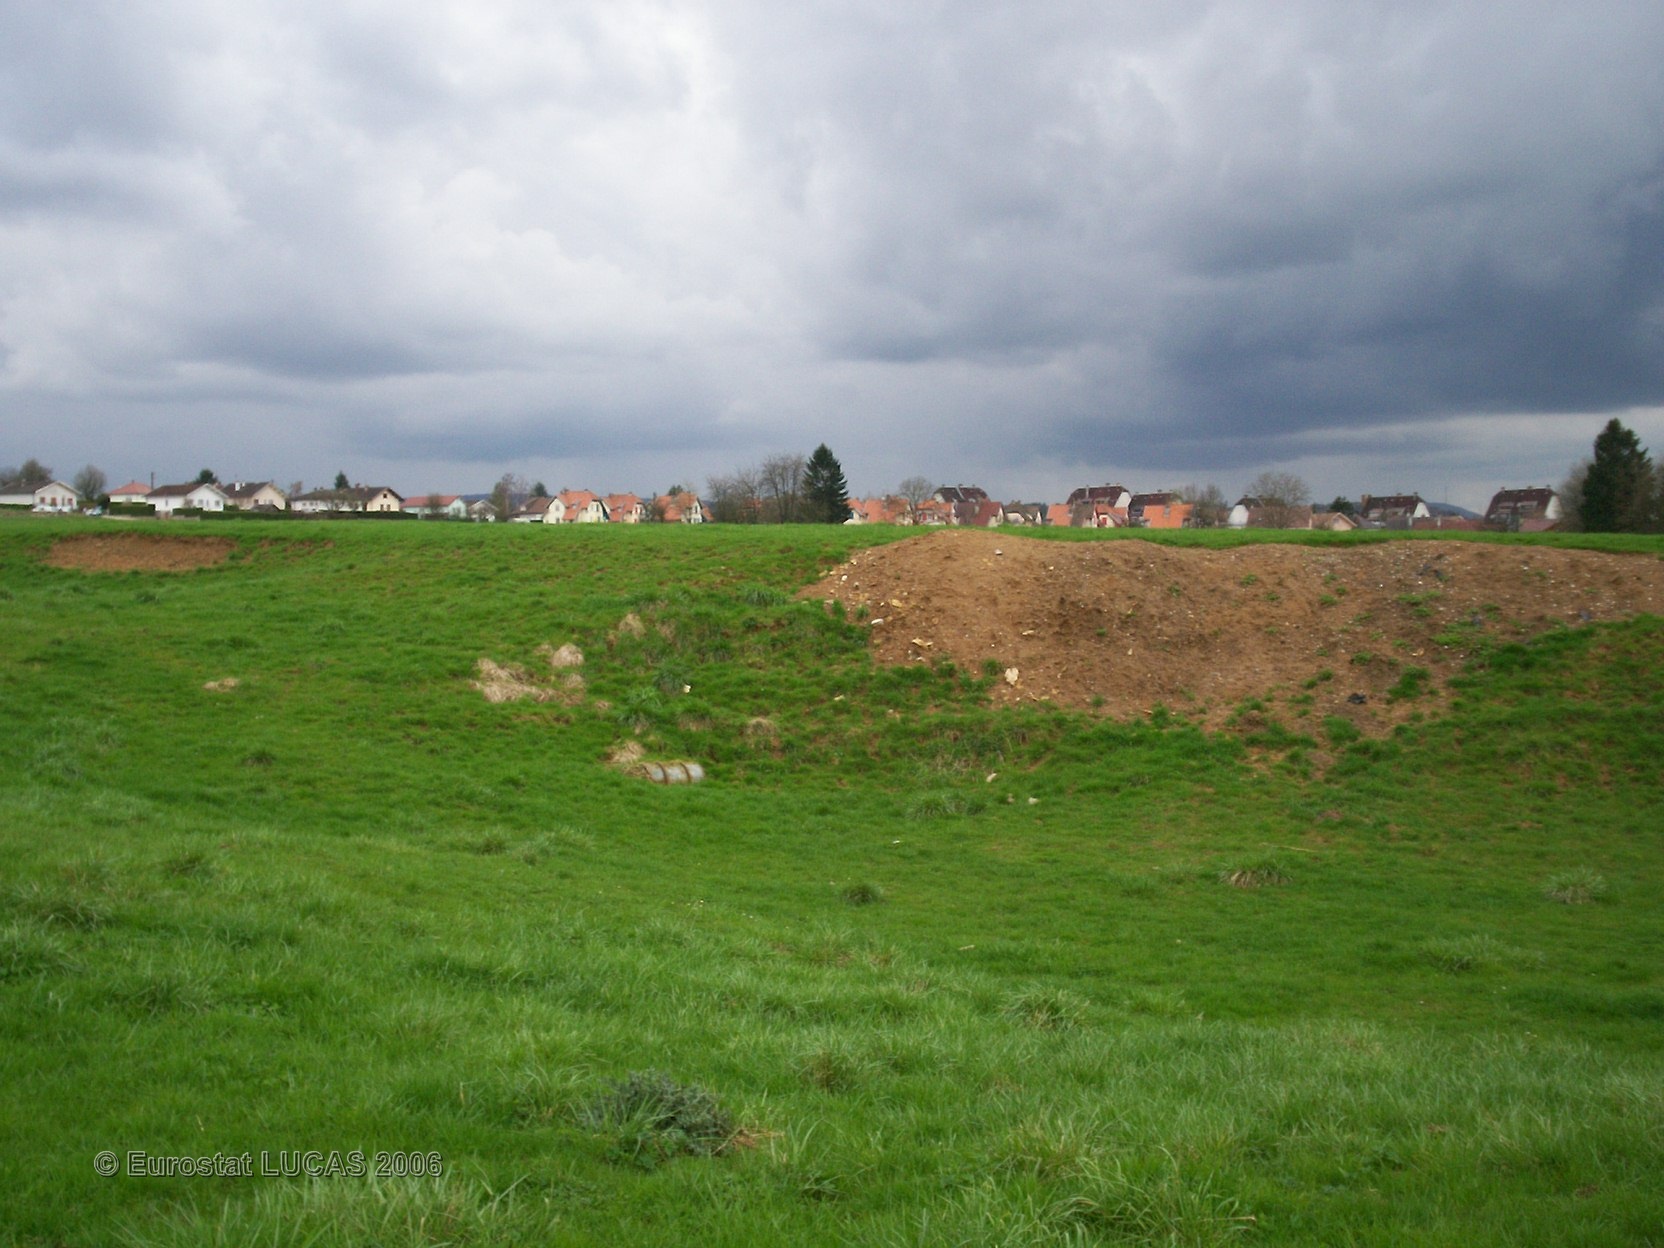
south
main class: Grassland
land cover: Grassland without tree/shrub cover
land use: Agriculture (excluding fallow land and kitchen gardens)
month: April
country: FR
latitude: 47.4504
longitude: 6.5932
